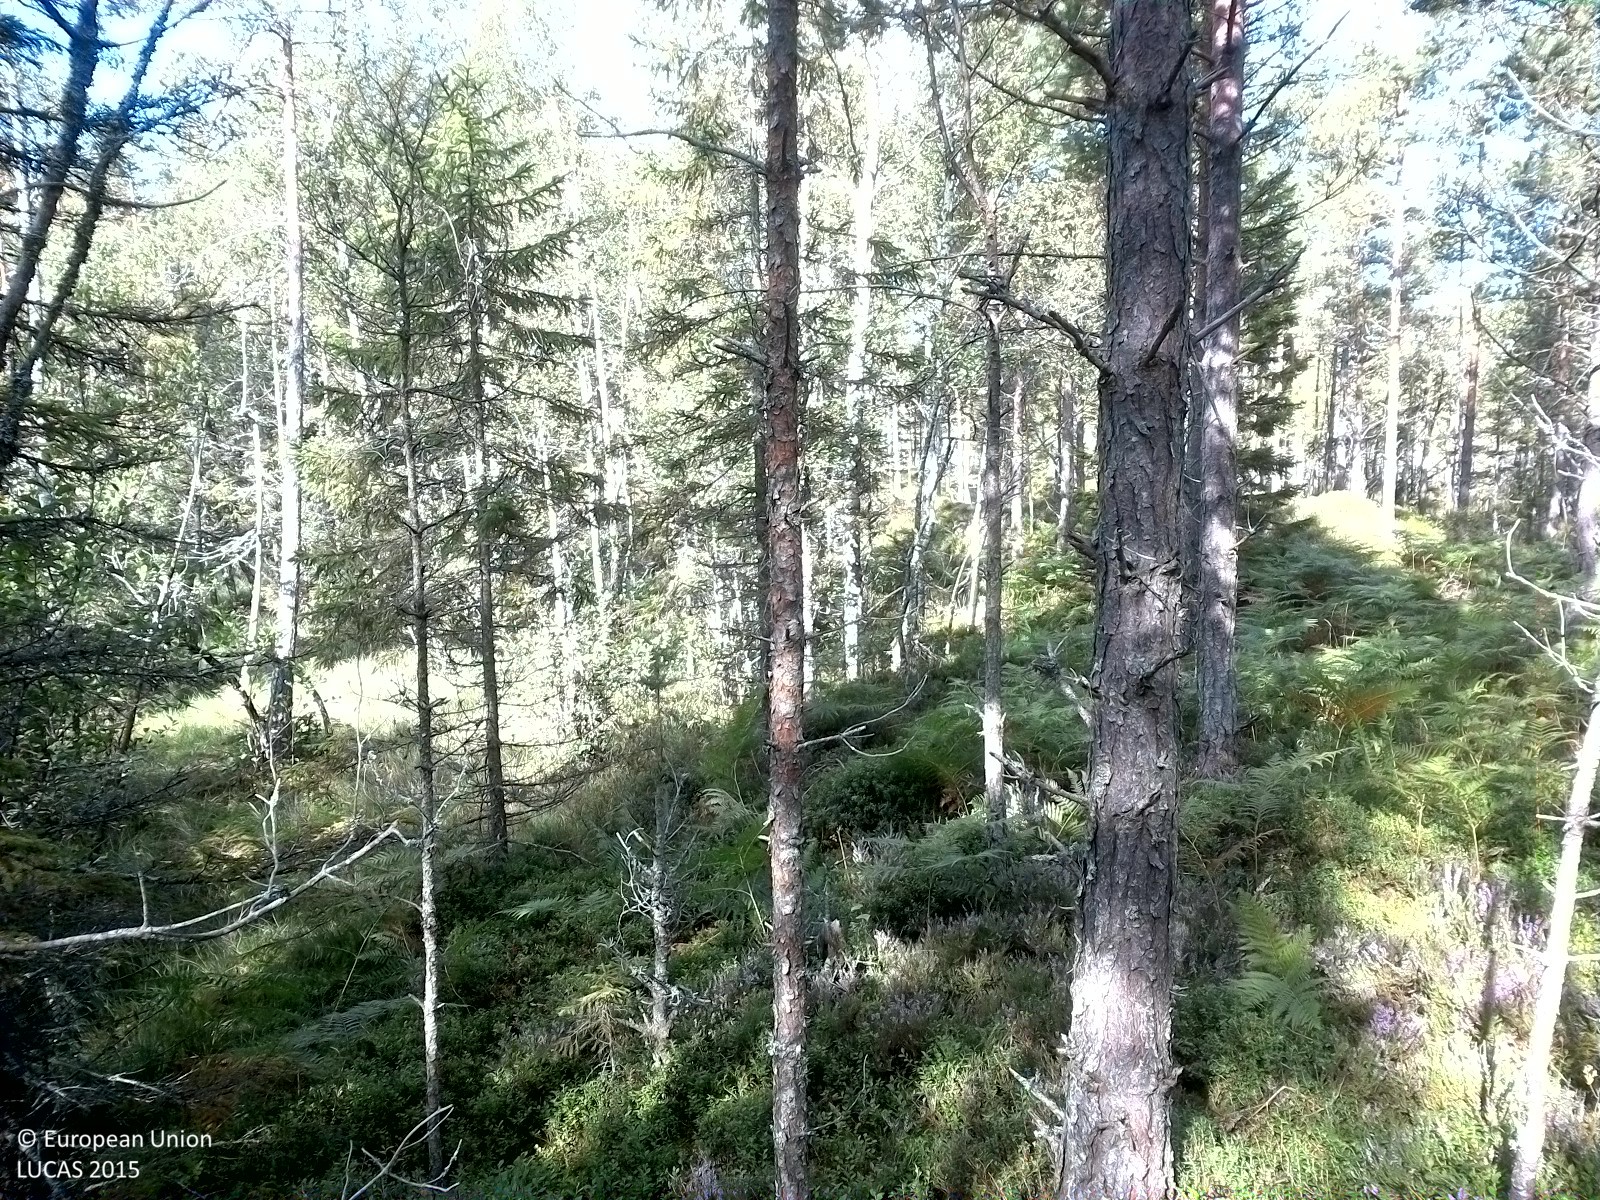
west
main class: Woodland
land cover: Pine dominated coniferous woodland
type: boreal forest
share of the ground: 25 - 50 %
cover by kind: herbaceous plants 45 %, coniferous forest trees 30 %, shrubs 15 %, lichens and mosses 10 %
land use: Forestry
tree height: > 5 m
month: August
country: SE
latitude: 58.9352
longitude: 15.5355
